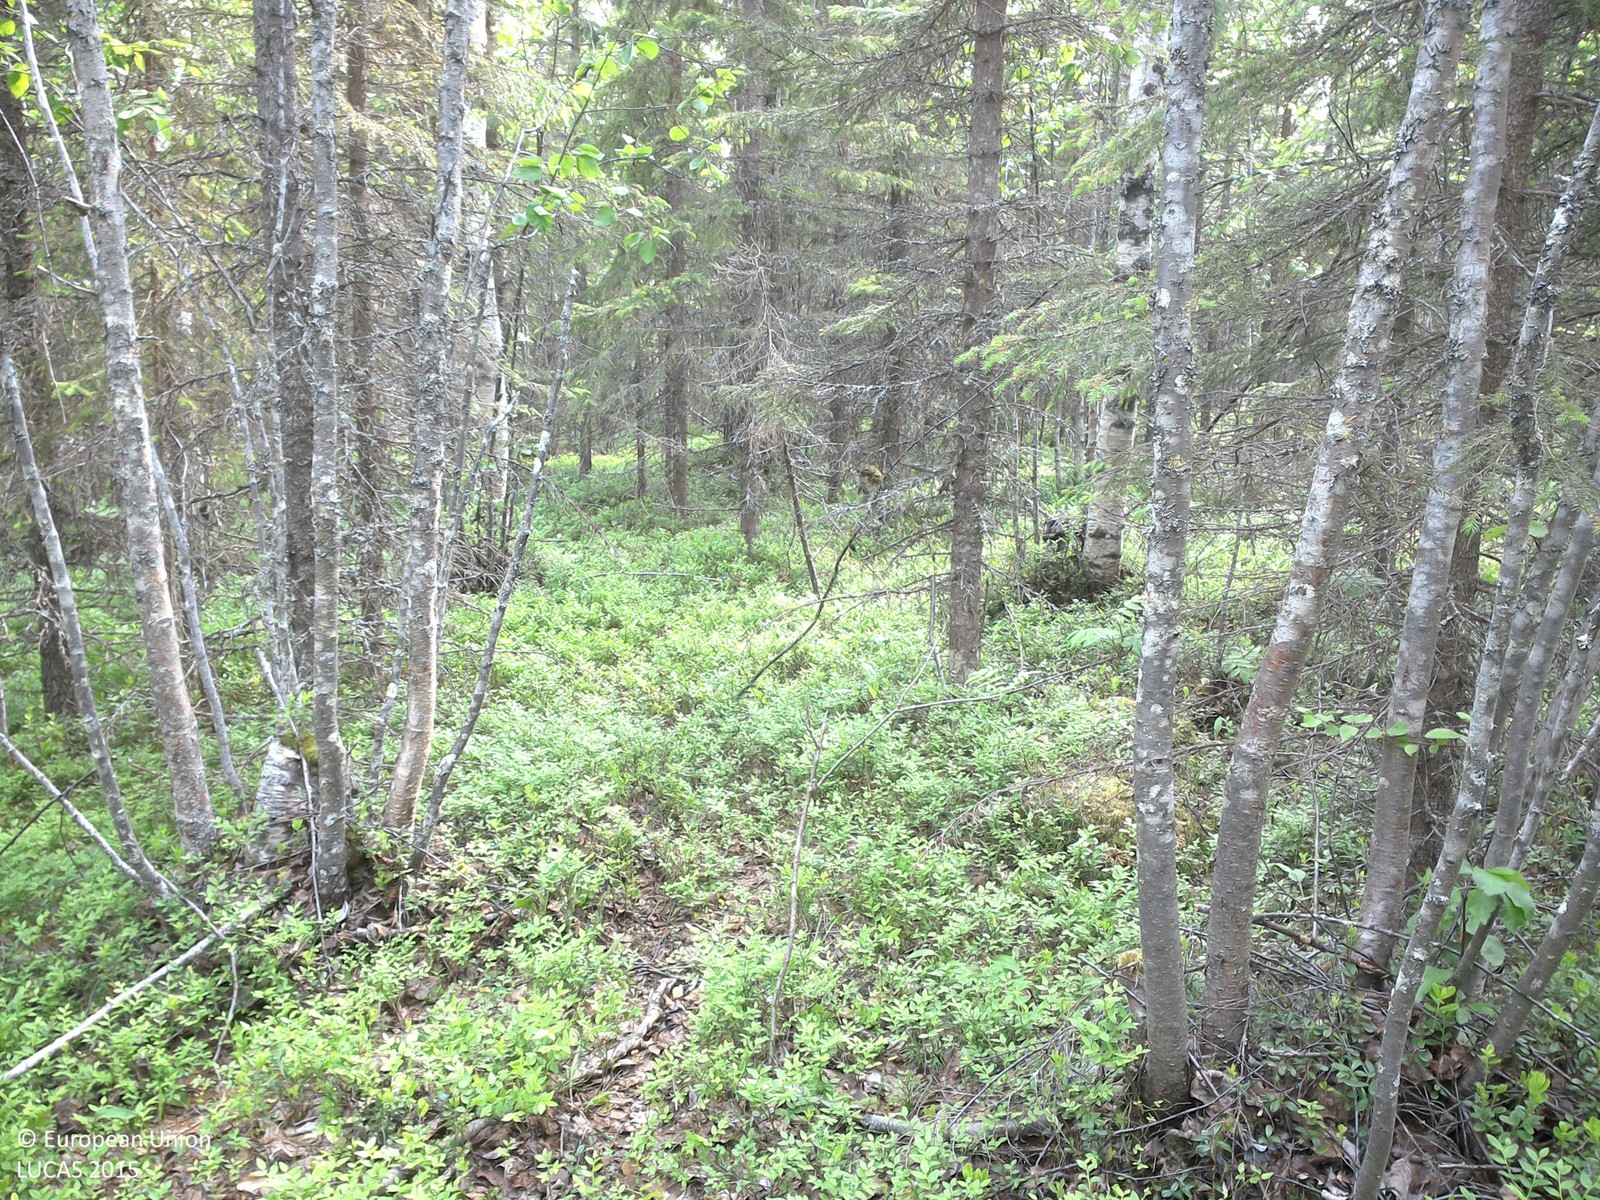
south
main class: Woodland
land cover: Spruce dominated mixed woodland
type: boreal forest
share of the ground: 10 - 25 %
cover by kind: shrubs 55 %, coniferous forest trees 30 %, broadleaved forest trees 15 %
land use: Forestry
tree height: > 5 m
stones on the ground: < 10 %
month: July
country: SE
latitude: 66.8483
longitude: 23.5874
